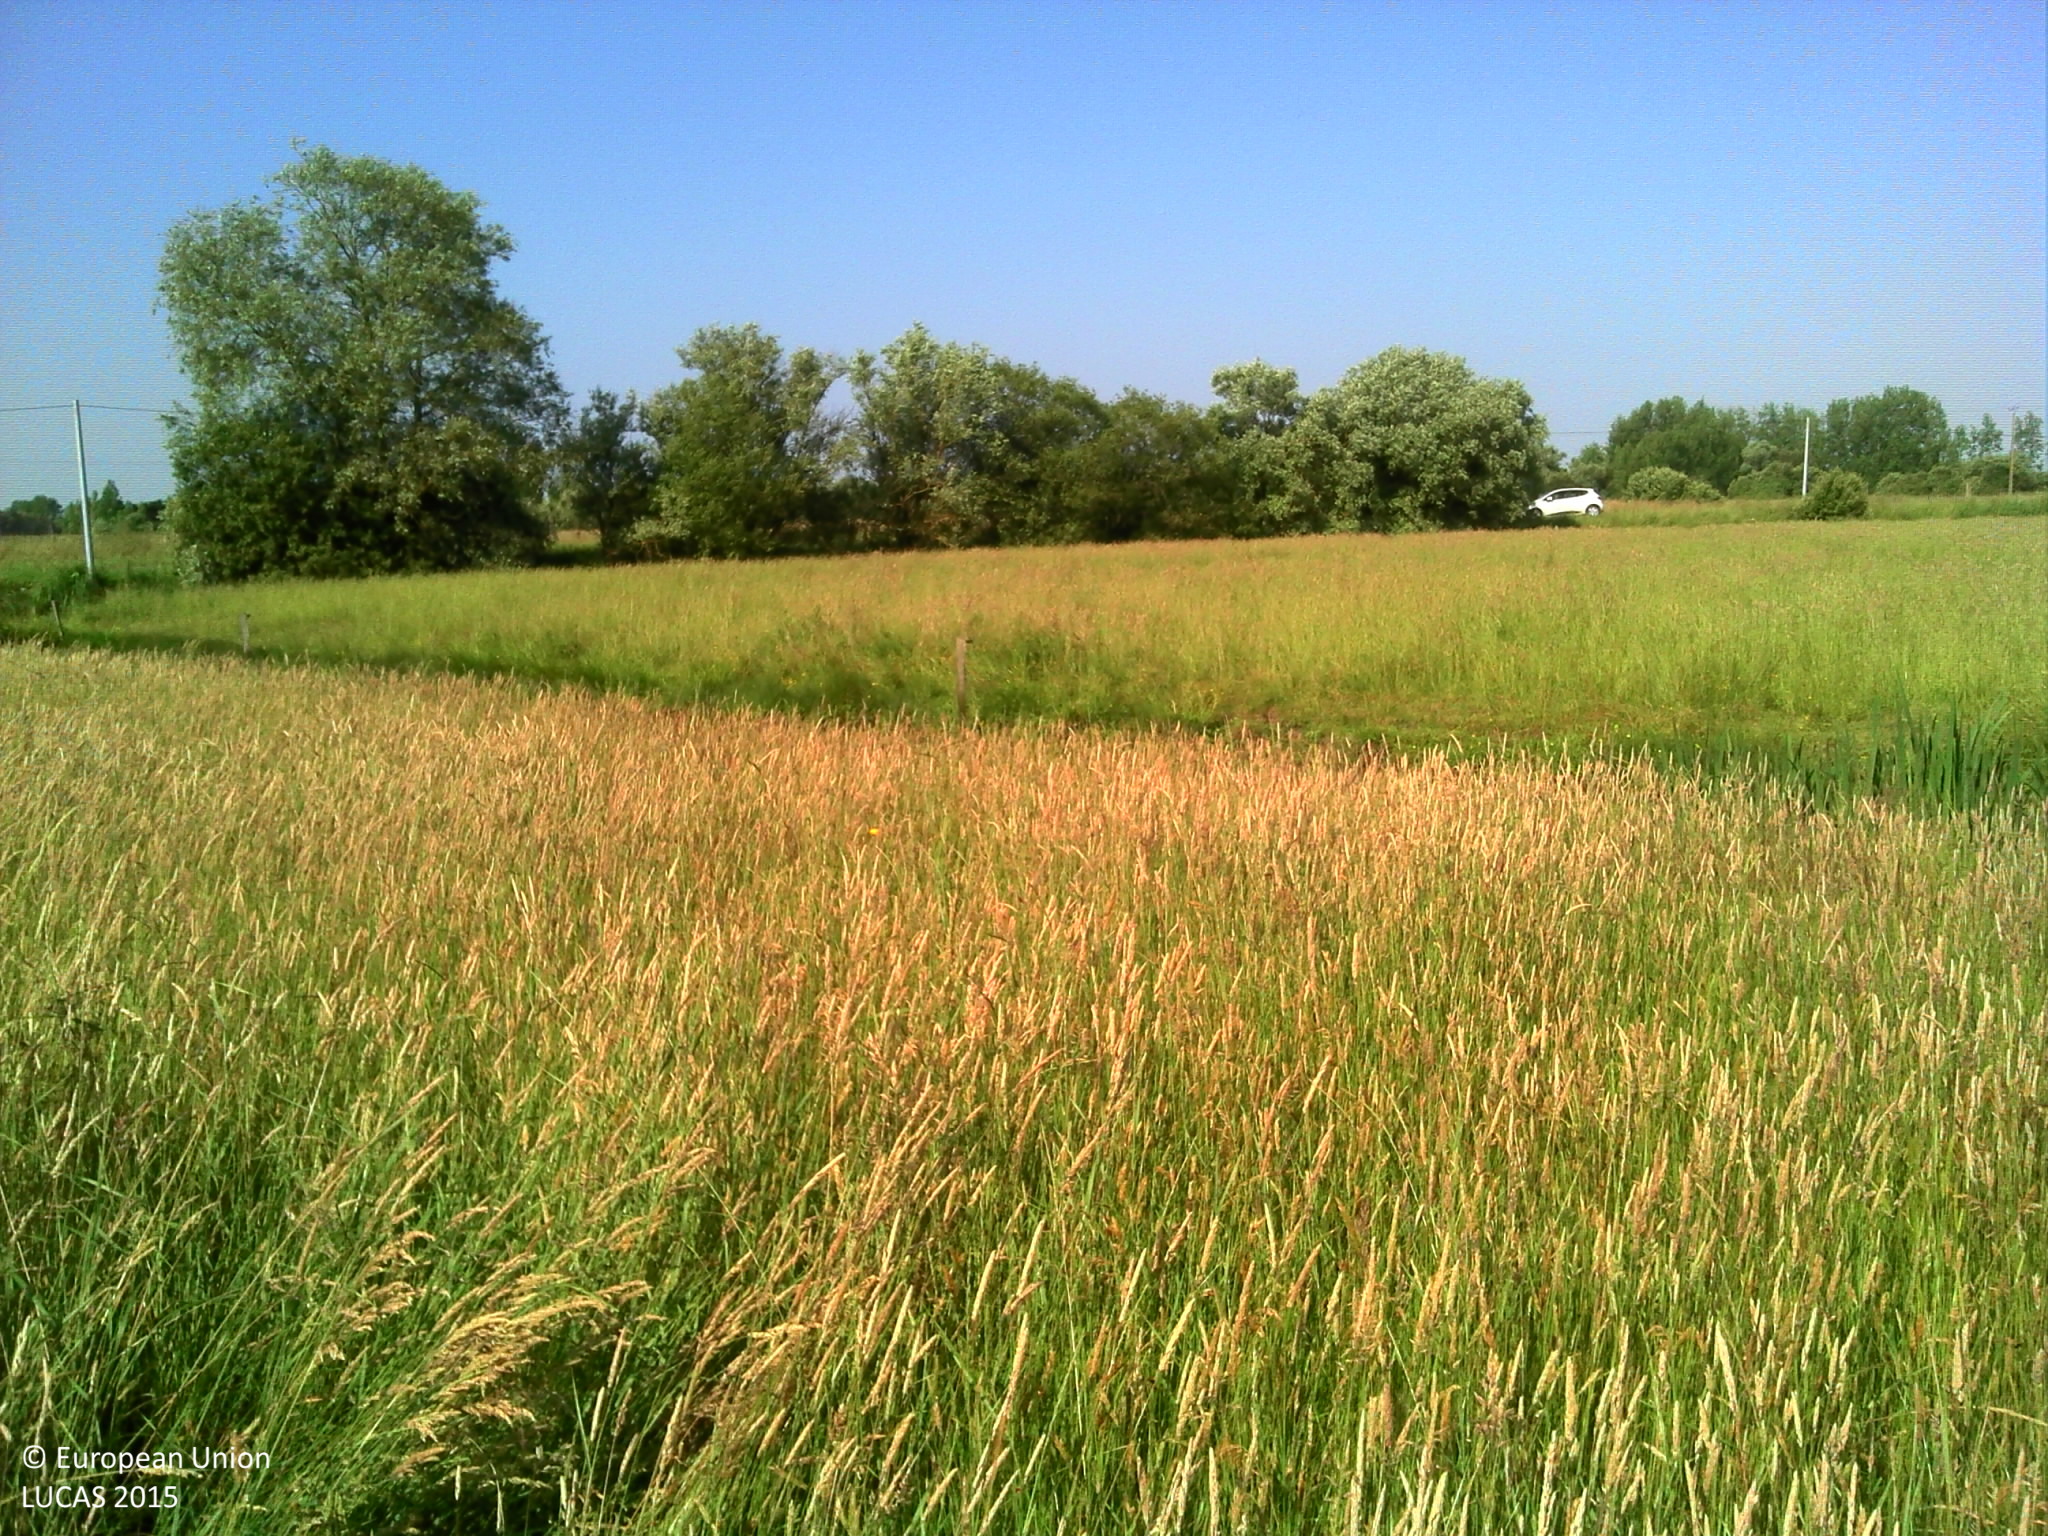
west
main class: Grassland
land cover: Grassland without tree/shrub cover
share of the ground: > 75 %
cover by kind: herbaceous plants 100 %
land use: Agriculture (excluding fallow land and kitchen gardens)
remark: Temporary flooded
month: June
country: FR
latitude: 46.8386
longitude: -1.9909
